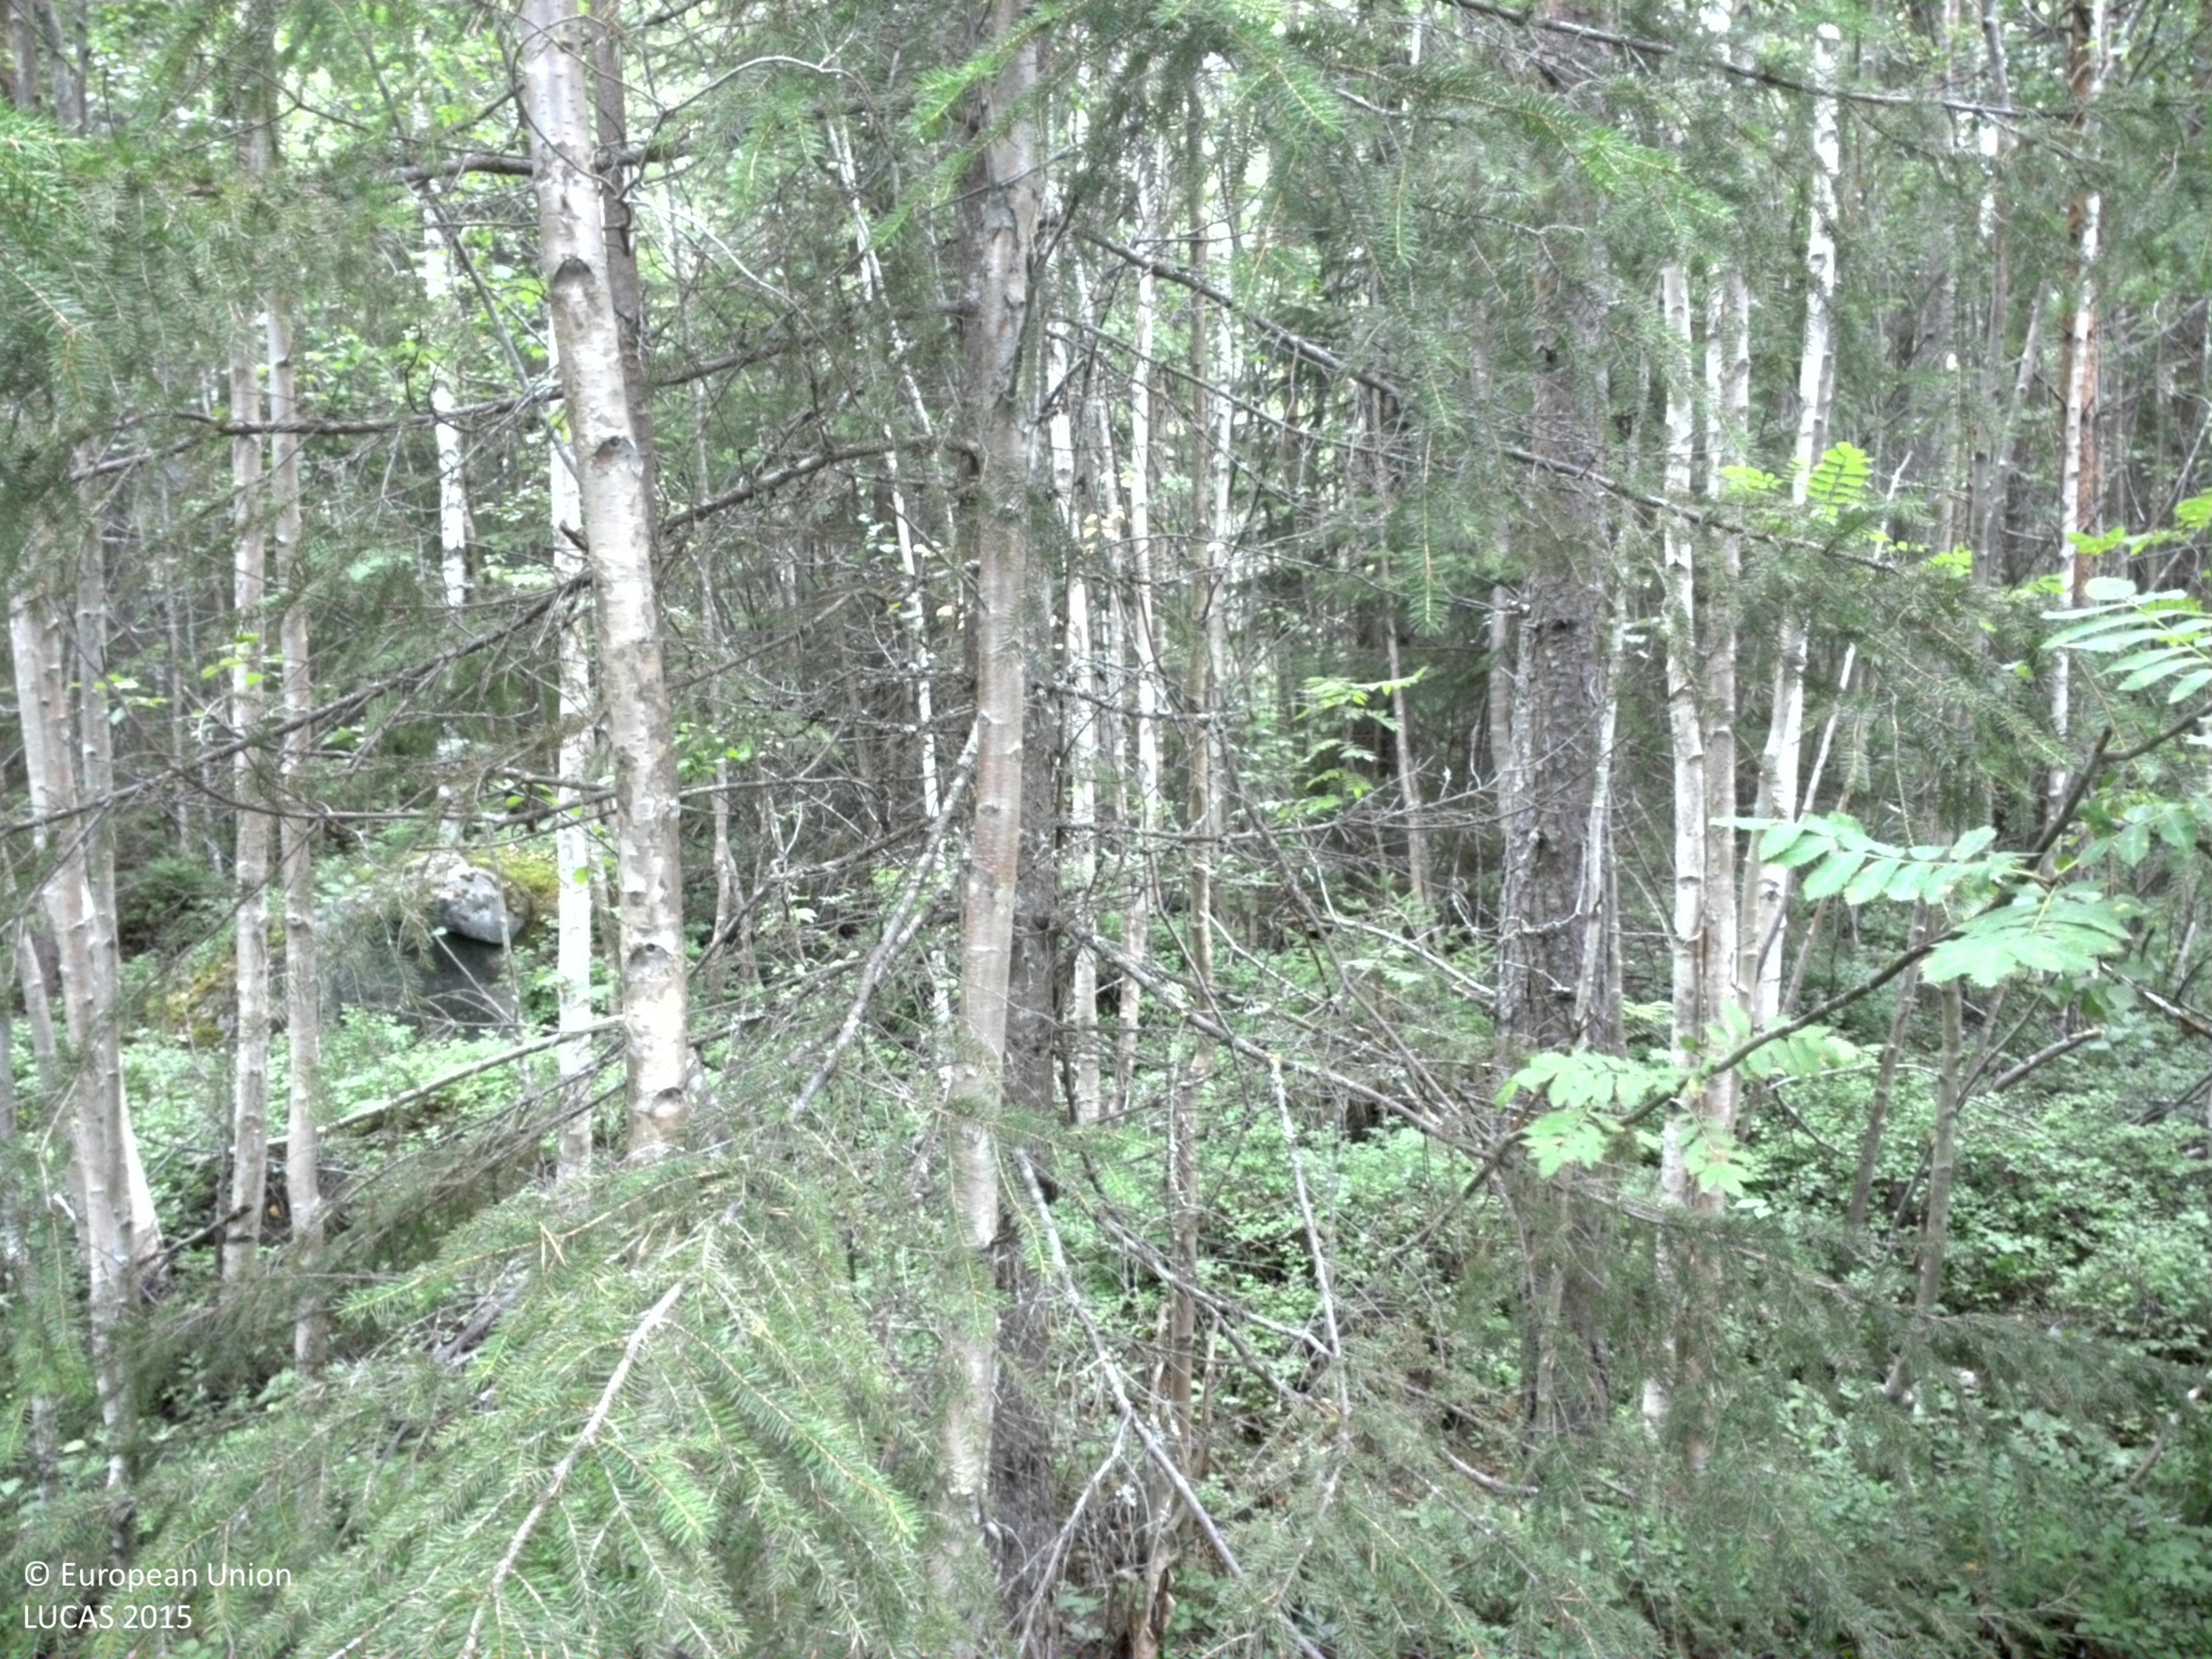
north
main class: Woodland
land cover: Spruce dominated mixed woodland
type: boreal forest
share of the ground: > 75 %
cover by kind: coniferous forest trees 60 %, broadleaved forest trees 20 %, shrubs 10 %, herbaceous plants 5 %, lichens and mosses 5 %
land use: Forestry
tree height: > 5 m
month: August
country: SE
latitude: 64.6619
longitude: 20.8894
